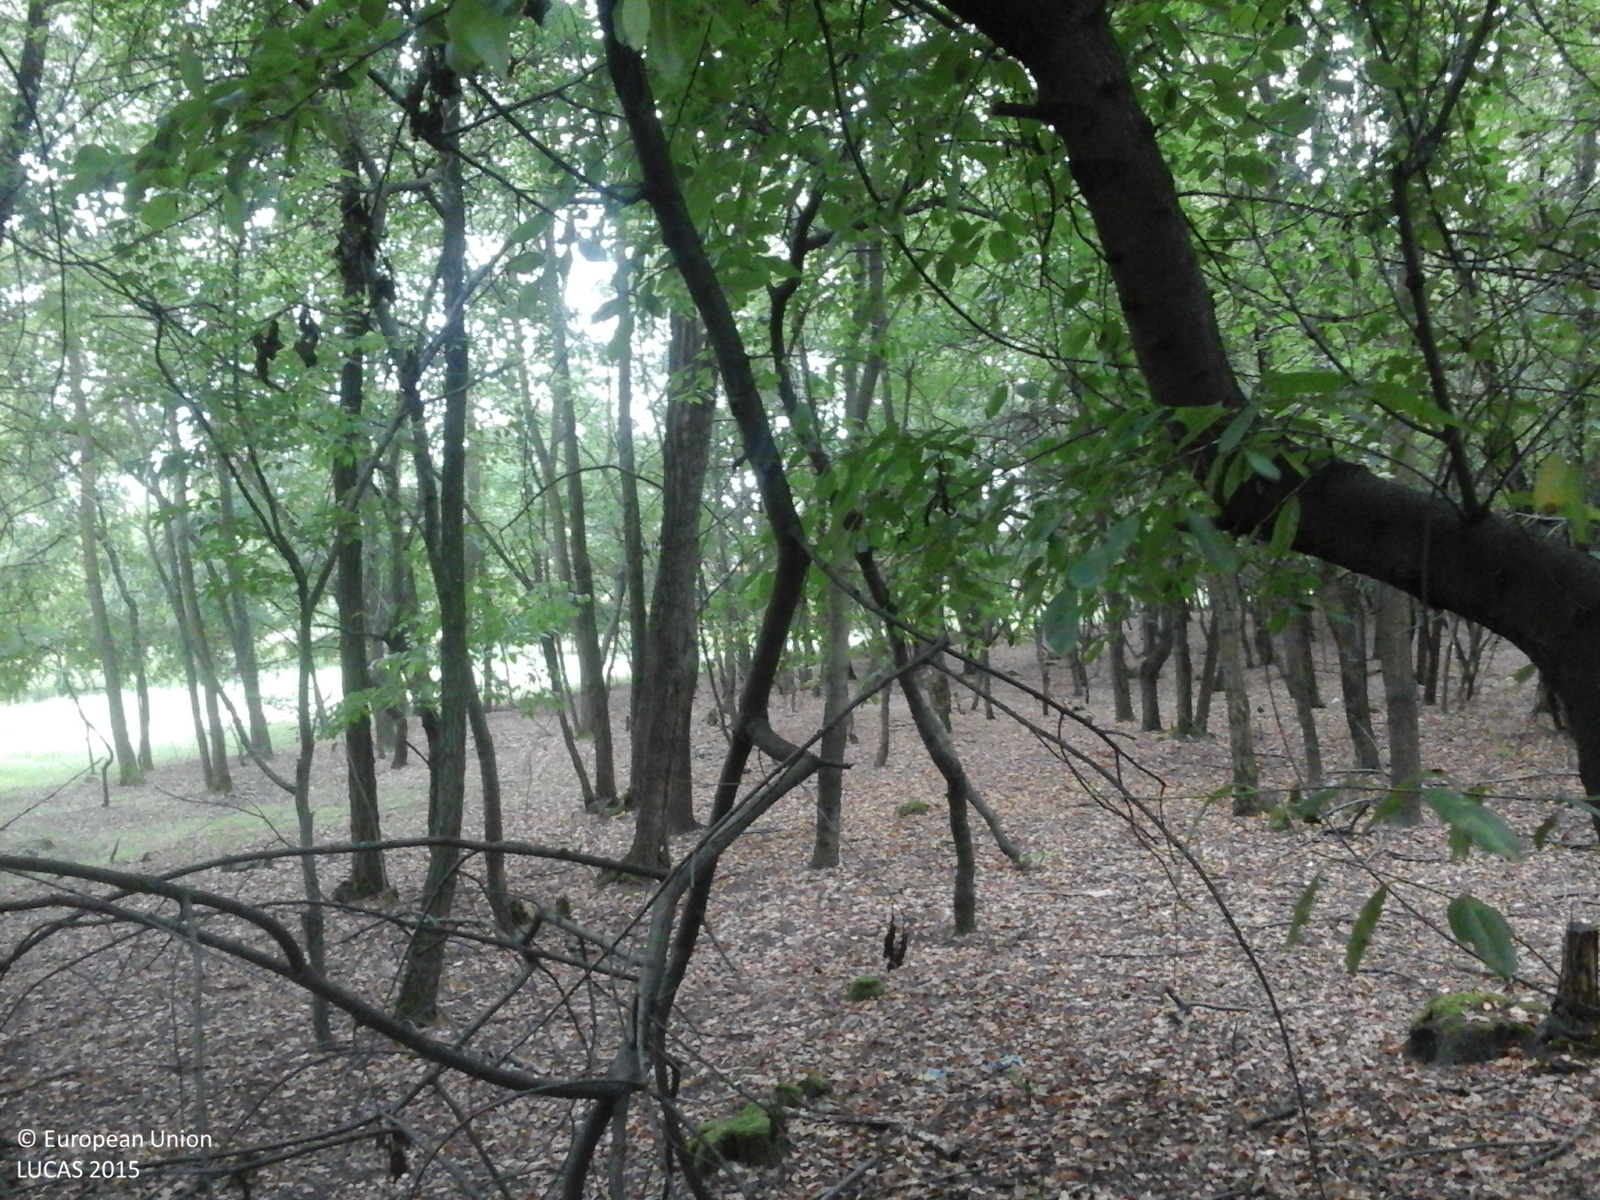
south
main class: Woodland
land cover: Broadleaved woodland
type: exotic forest
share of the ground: > 75 %
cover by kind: broadleaved forest trees 100 %
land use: Forestry
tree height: > 5 m
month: September
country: RO
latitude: 47.5035
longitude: 22.0654
